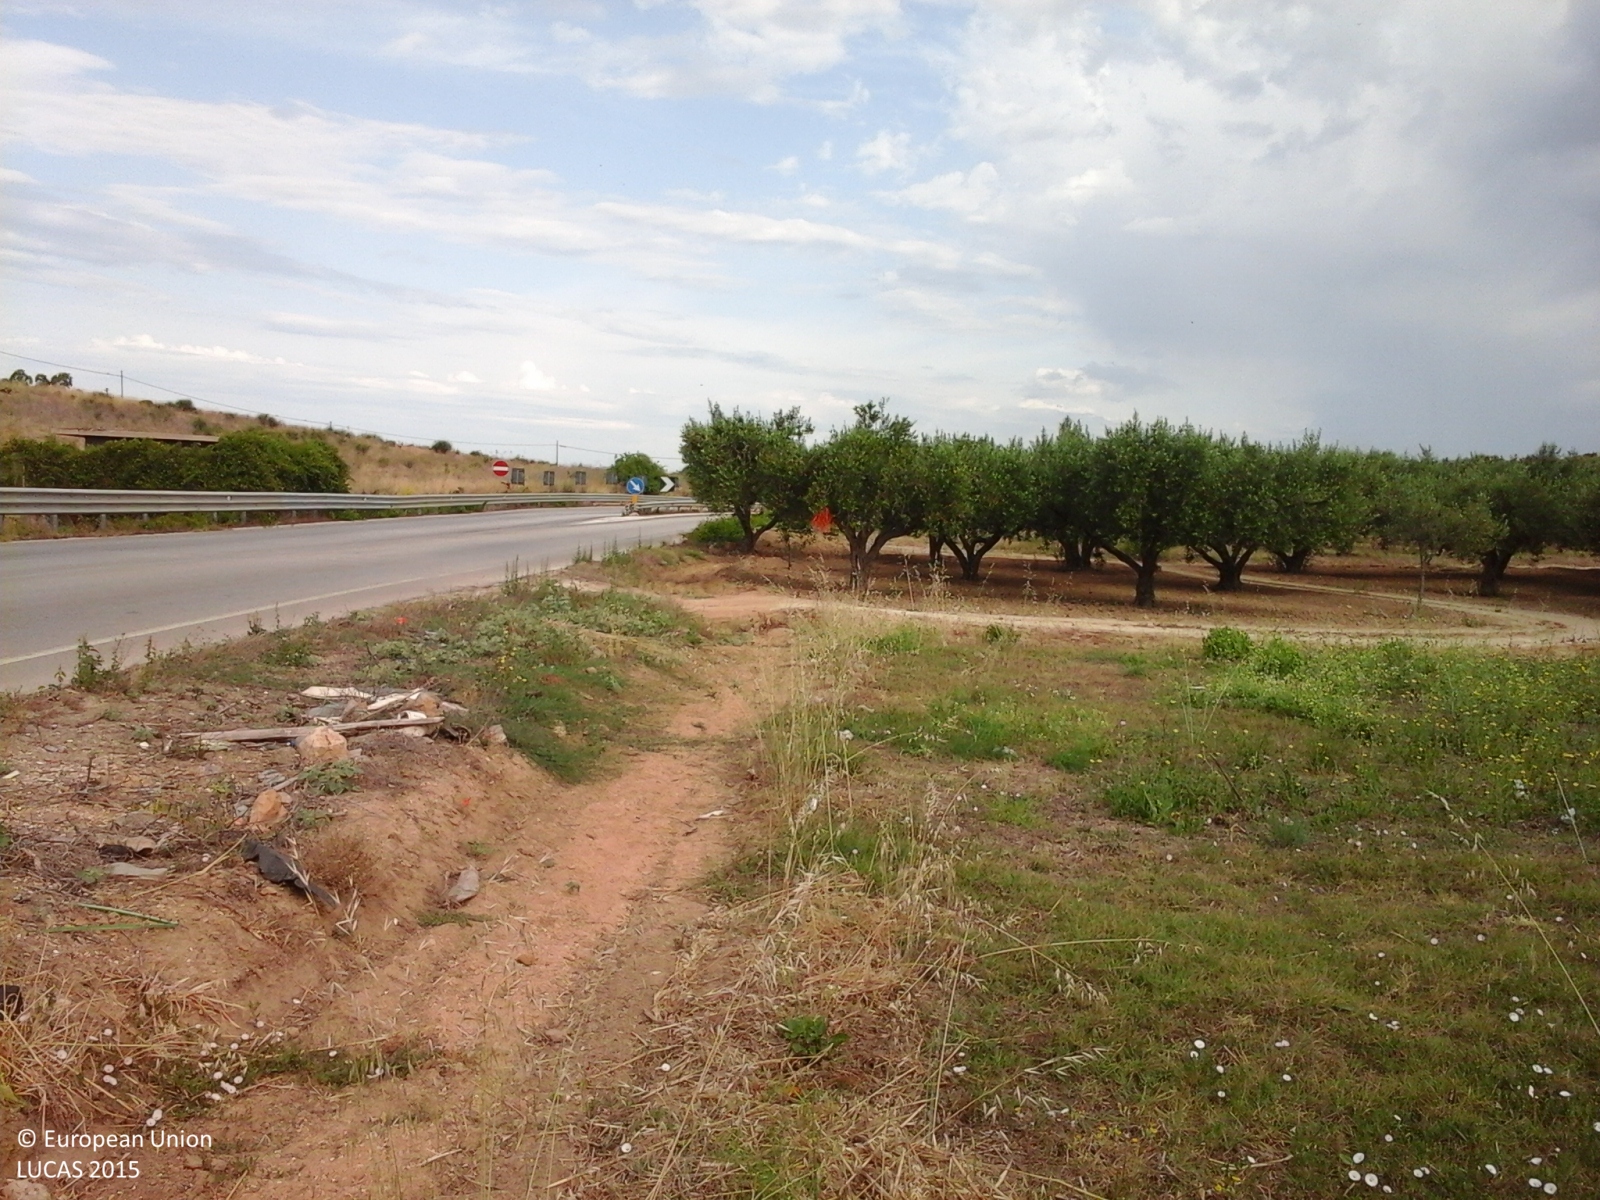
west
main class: Cropland
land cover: Olive groves
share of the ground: 25 - 50 %
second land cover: Grassland without tree/shrub cover
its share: > 75 %
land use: Agriculture (excluding fallow land and kitchen gardens)
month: June
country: IT
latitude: 37.4947
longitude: 13.1765
